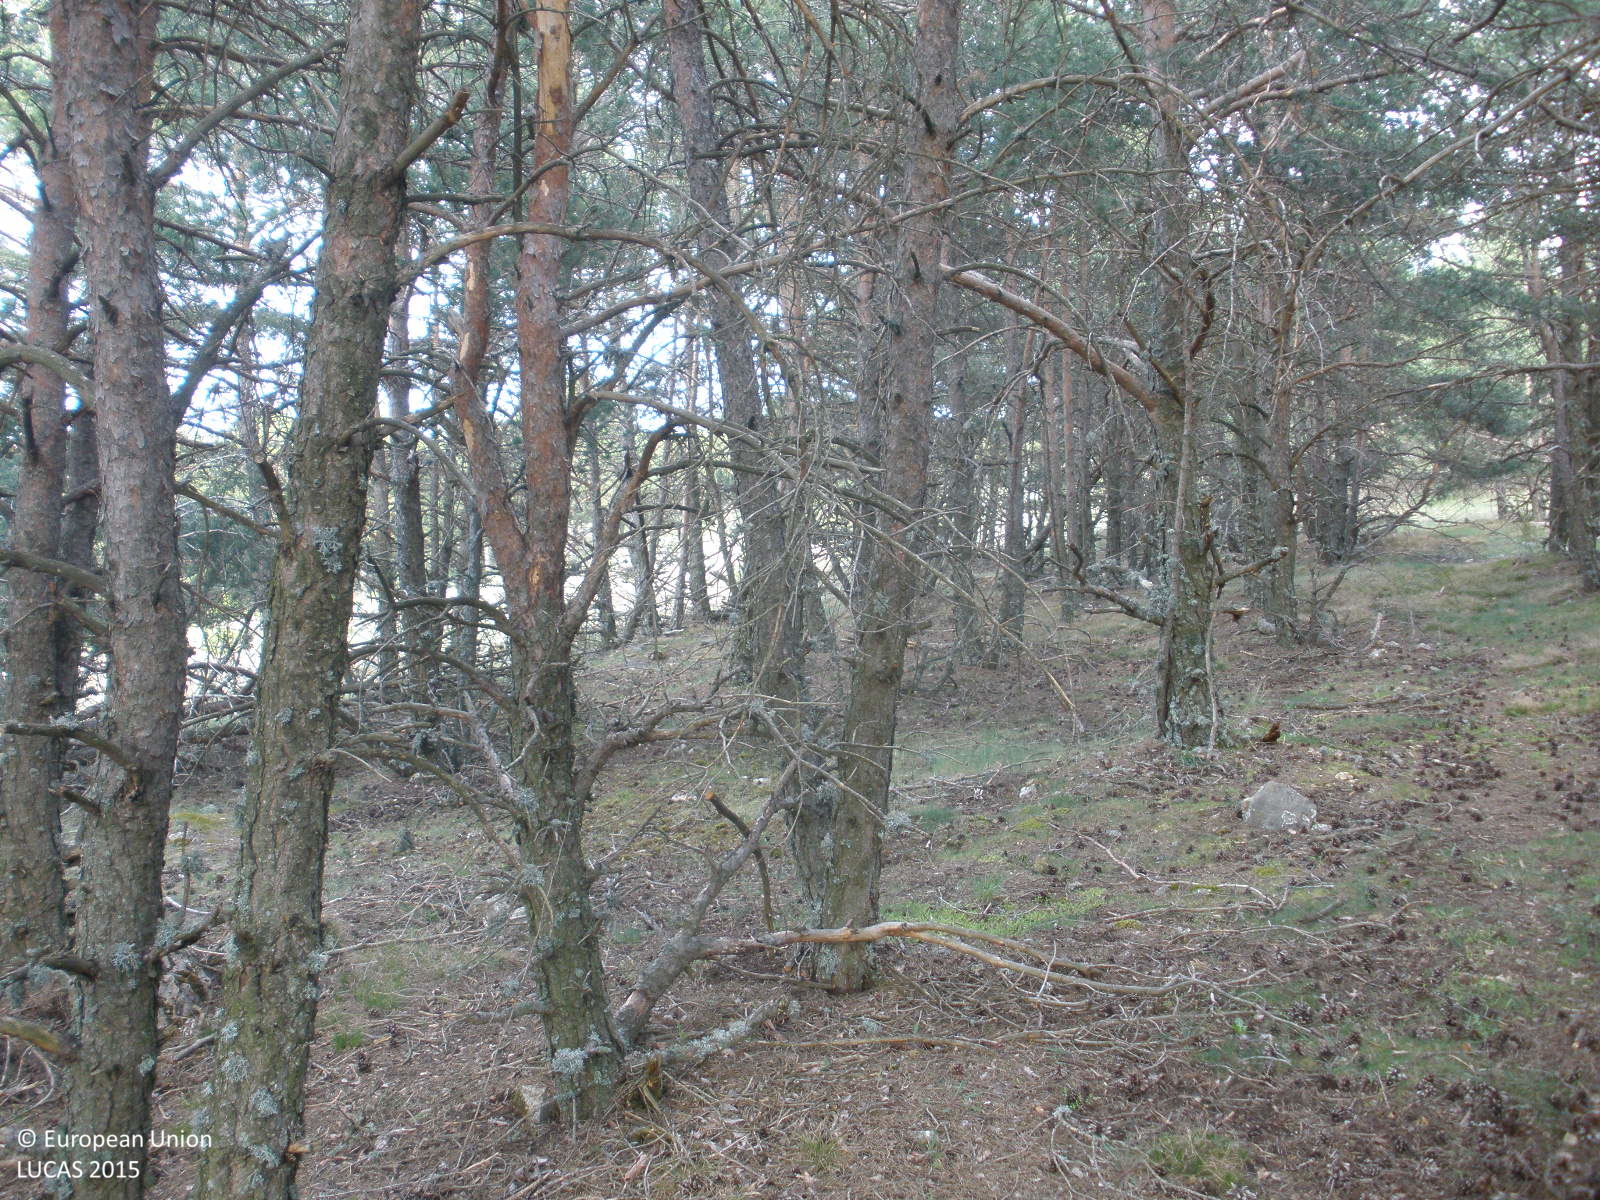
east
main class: Woodland
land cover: Pine dominated coniferous woodland
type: coniferous forest of the mediterranean region
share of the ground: > 75 %
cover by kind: coniferous forest trees 90 %, herbaceous plants 10 %
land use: Forestry
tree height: > 5 m
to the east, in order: Pine dominated coniferous woodland; Other structural elements; Tracks; Other structural elements; Pine dominated coniferous woodland
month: May
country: ES
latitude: 40.5762
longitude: -0.8439
